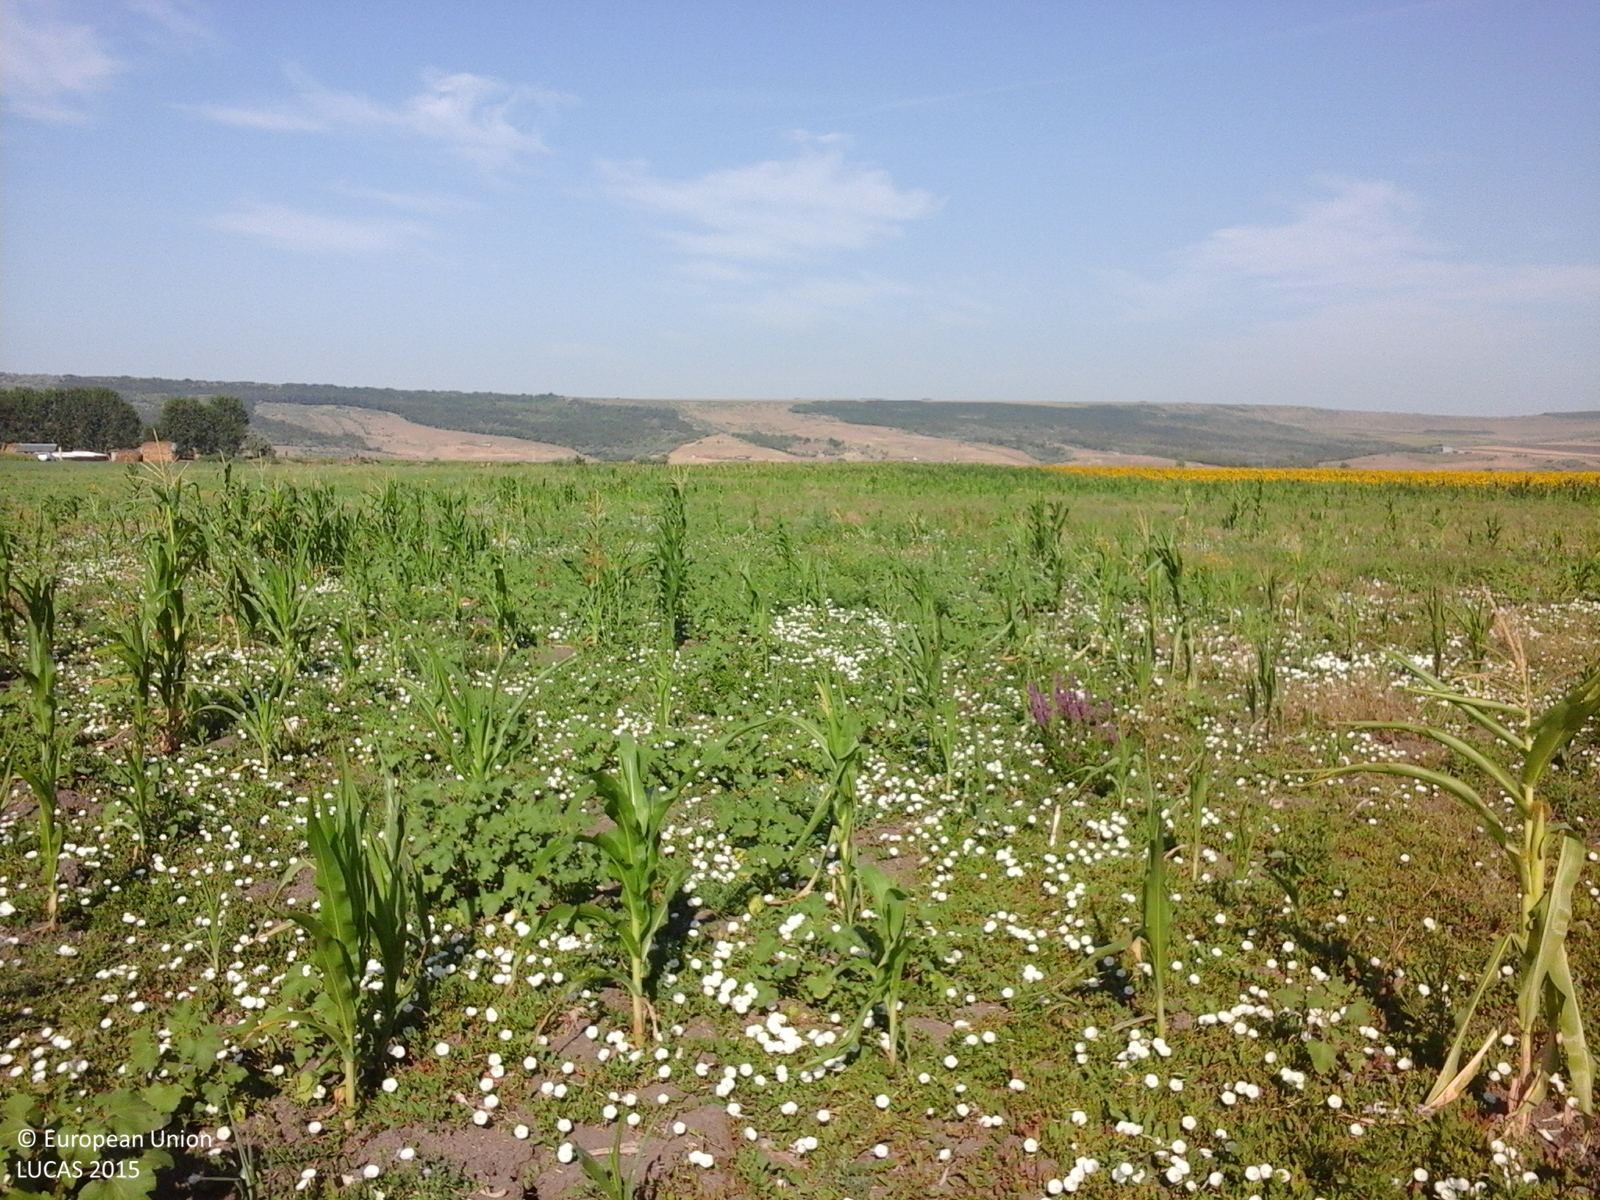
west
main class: Cropland
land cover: Maize
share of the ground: 50 - 75 %
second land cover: Spontaneously vegetated surfaces
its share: 25 - 50 %
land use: Agriculture (excluding fallow land and kitchen gardens)
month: July
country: RO
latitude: 46.5444
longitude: 28.1947
